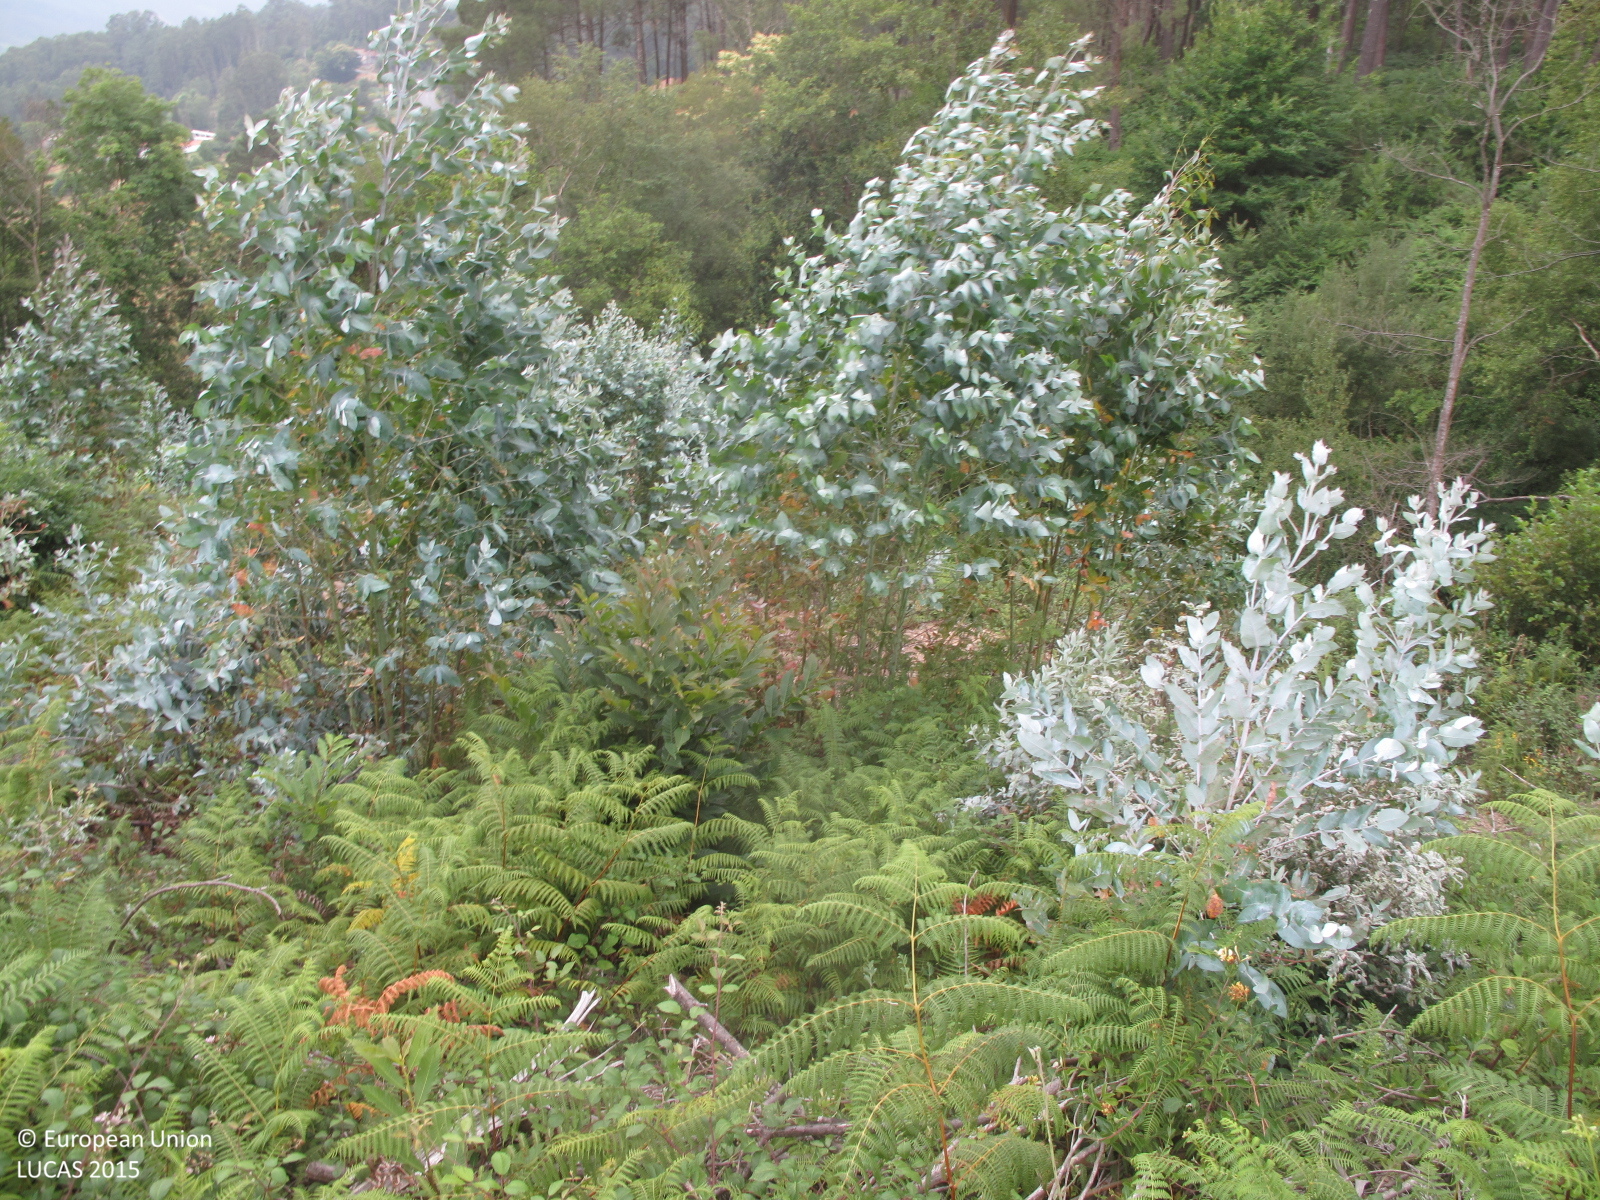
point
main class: Woodland
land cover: Broadleaved woodland
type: exotic forest
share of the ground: 10 - 25 %
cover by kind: herbaceous plants 40 %, broadleaved forest trees 20 %, shrubs 20 %, unconsolidated bare surface 20 %
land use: Forestry
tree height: < 5 m
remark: Clear cut
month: July
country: ES
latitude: 43.3824
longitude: -8.1326
